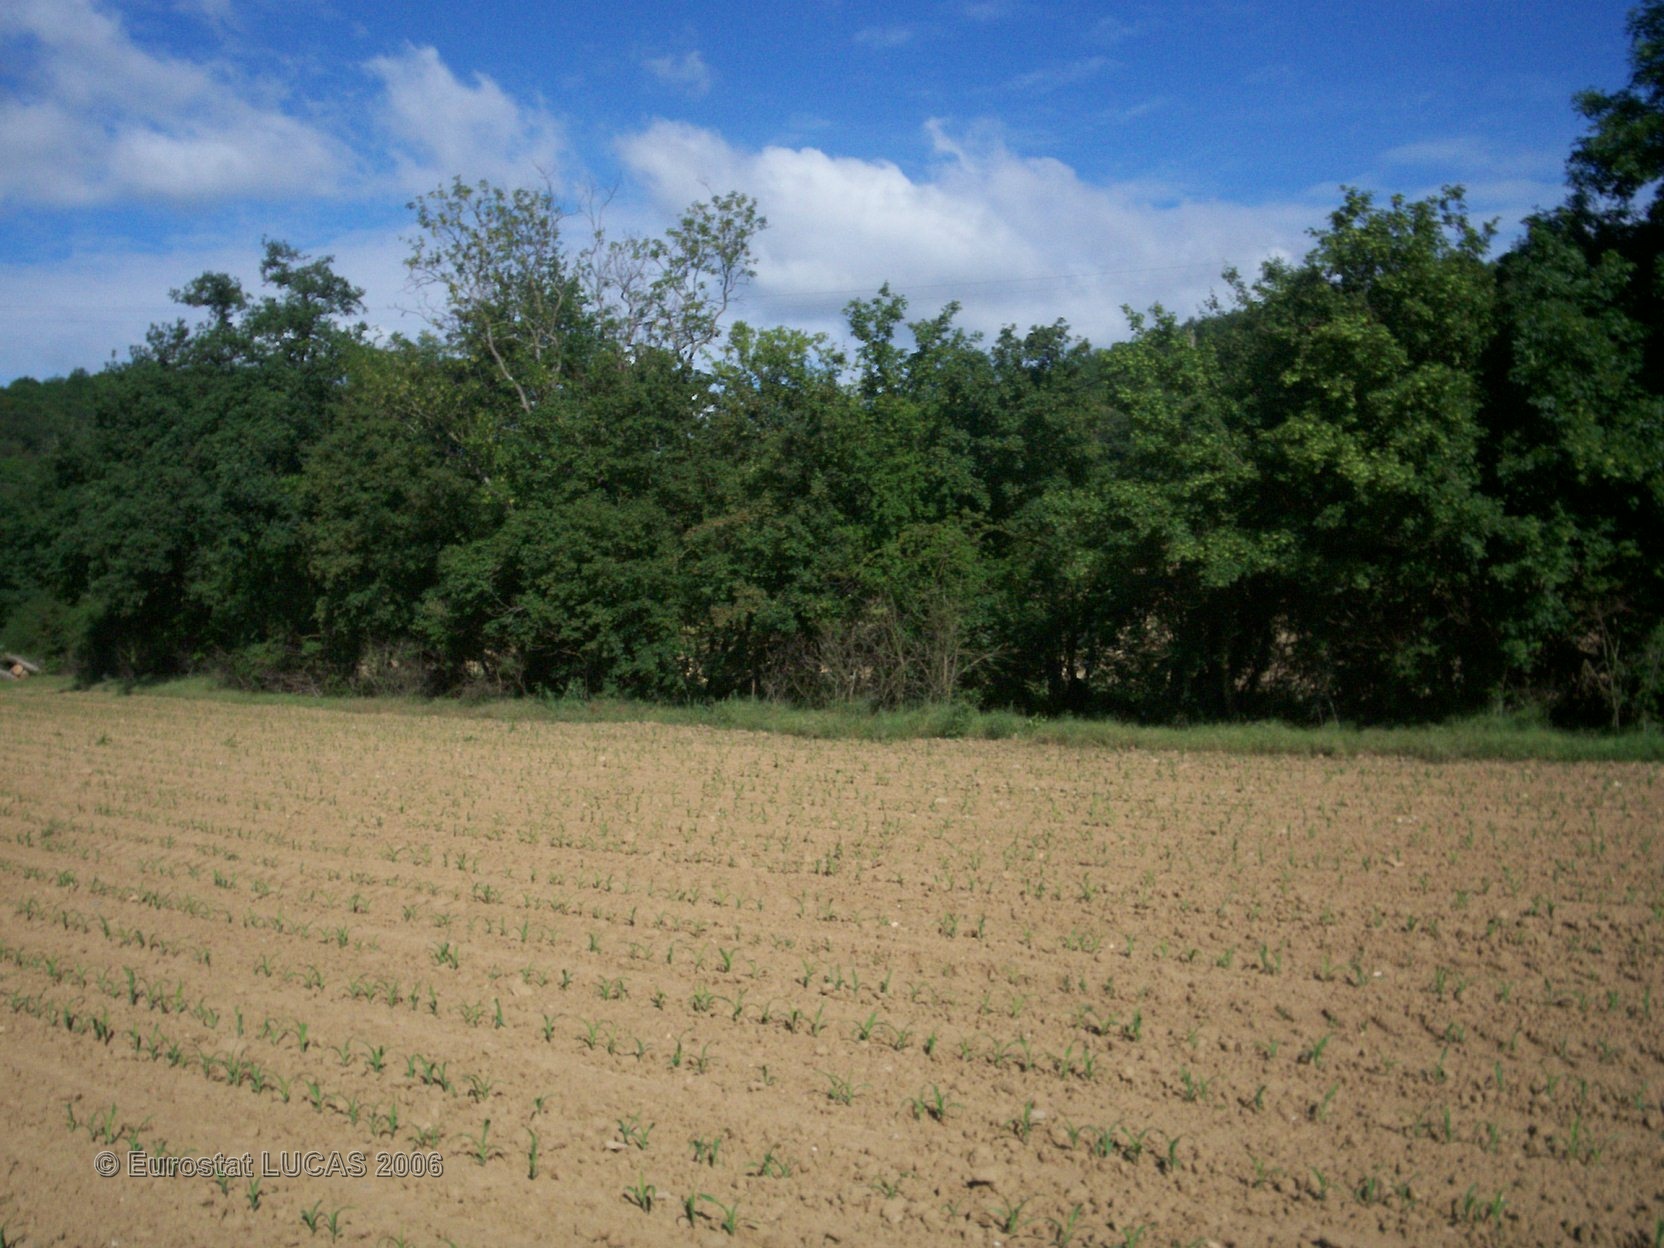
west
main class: Cropland
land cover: Maize
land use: Agriculture (excluding fallow land and kitchen gardens)
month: May
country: FR
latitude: 45.6090
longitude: 4.7595
